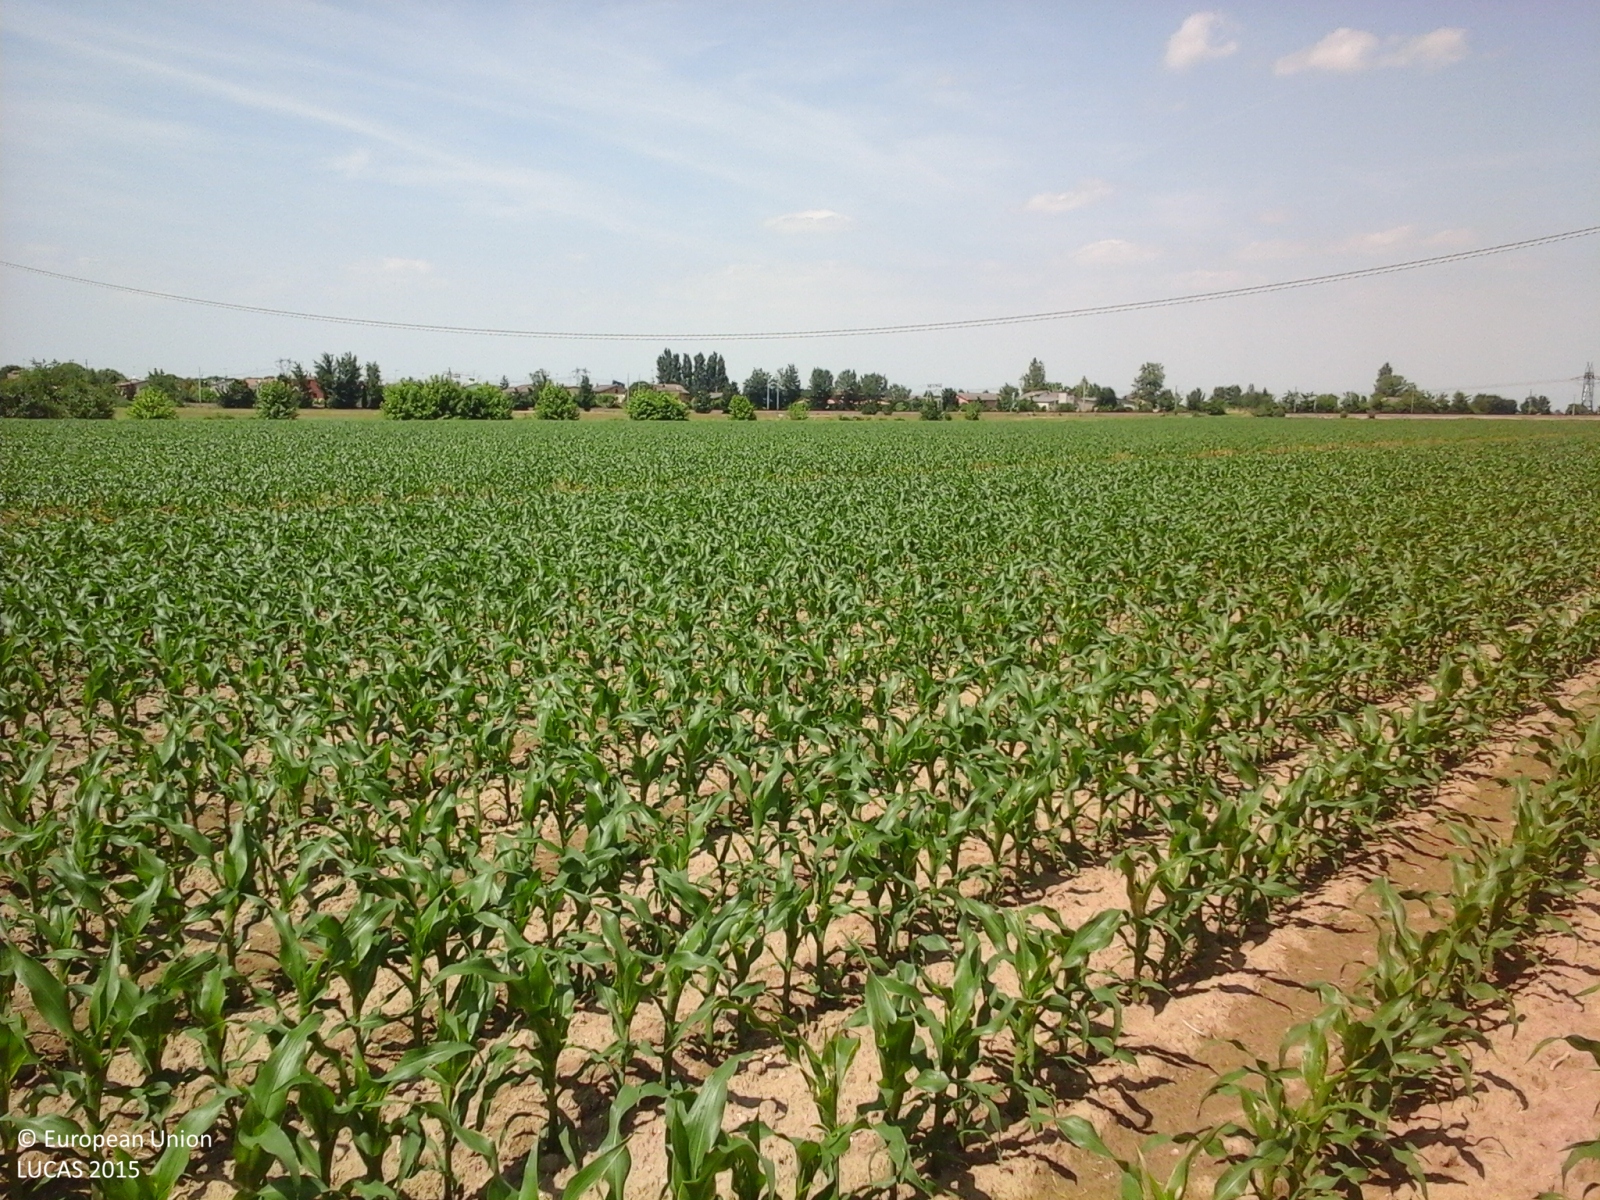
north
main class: Cropland
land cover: Maize
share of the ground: 25 - 50 %
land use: Agriculture (excluding fallow land and kitchen gardens)
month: May
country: IT
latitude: 45.1761
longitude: 10.9018
